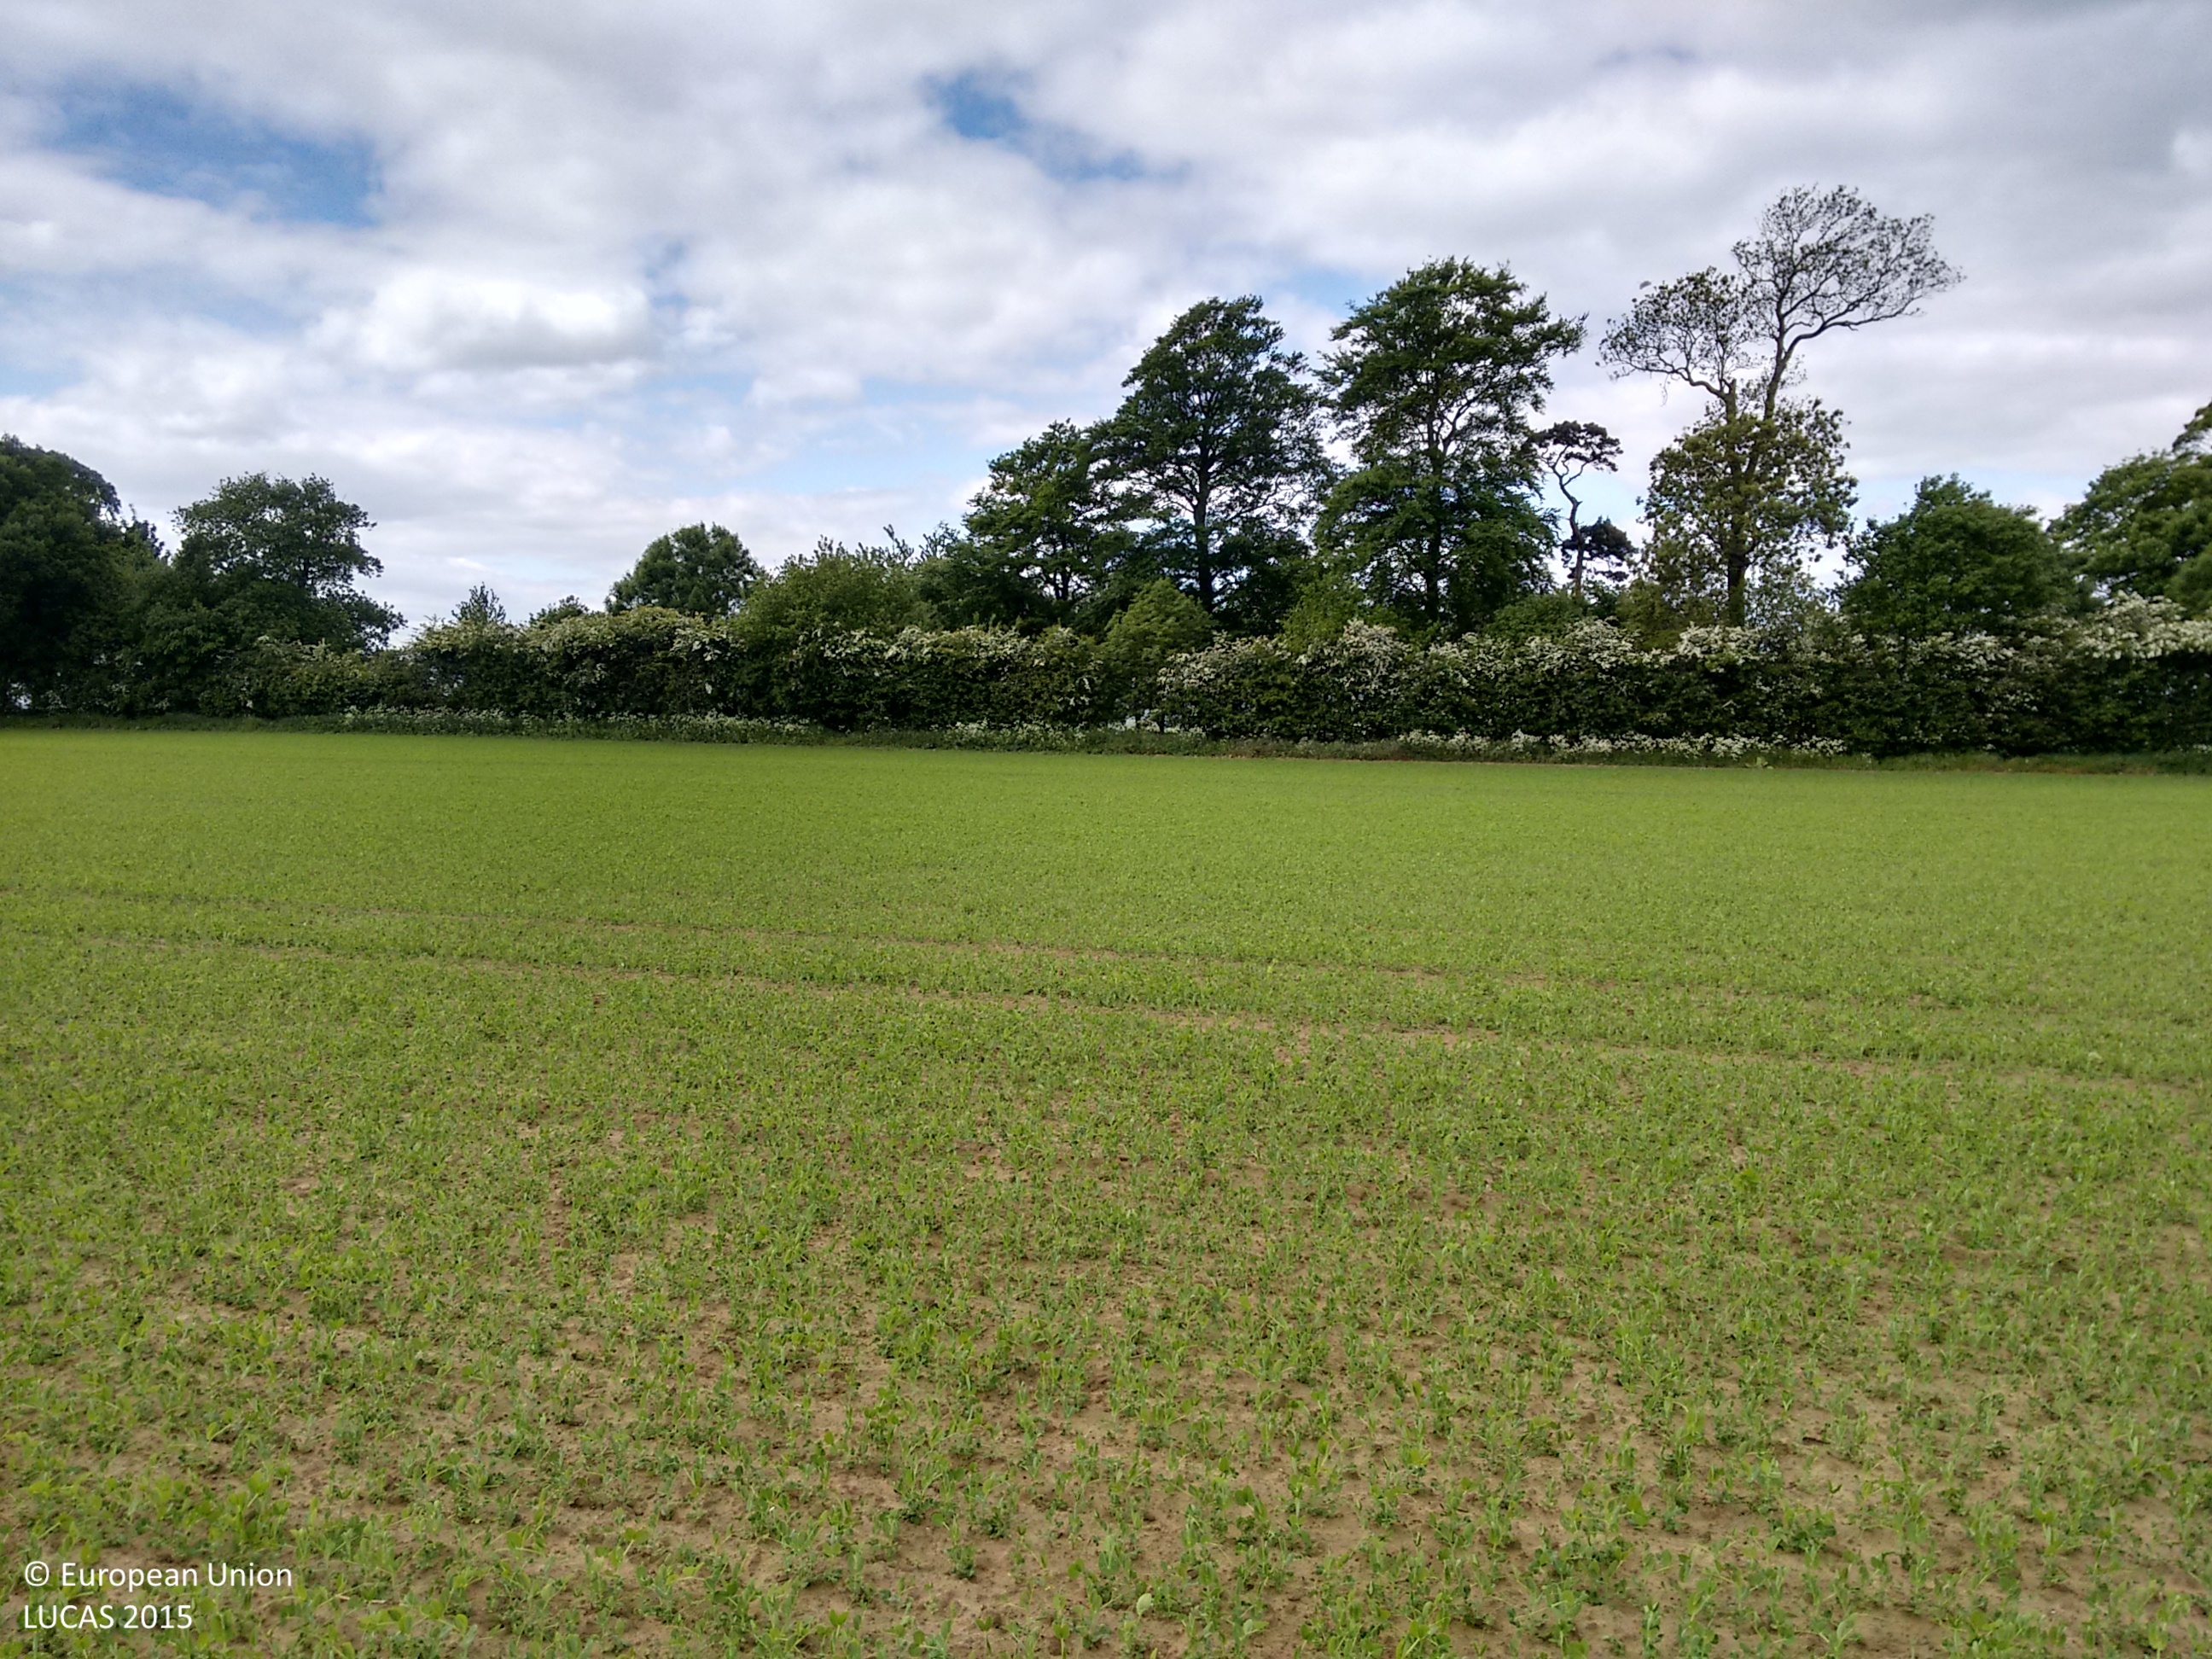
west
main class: Cropland
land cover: Dry pulses
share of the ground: 25 - 50 %
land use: Agriculture (excluding fallow land and kitchen gardens)
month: May
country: GB
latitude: 53.6720
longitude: -0.6803
